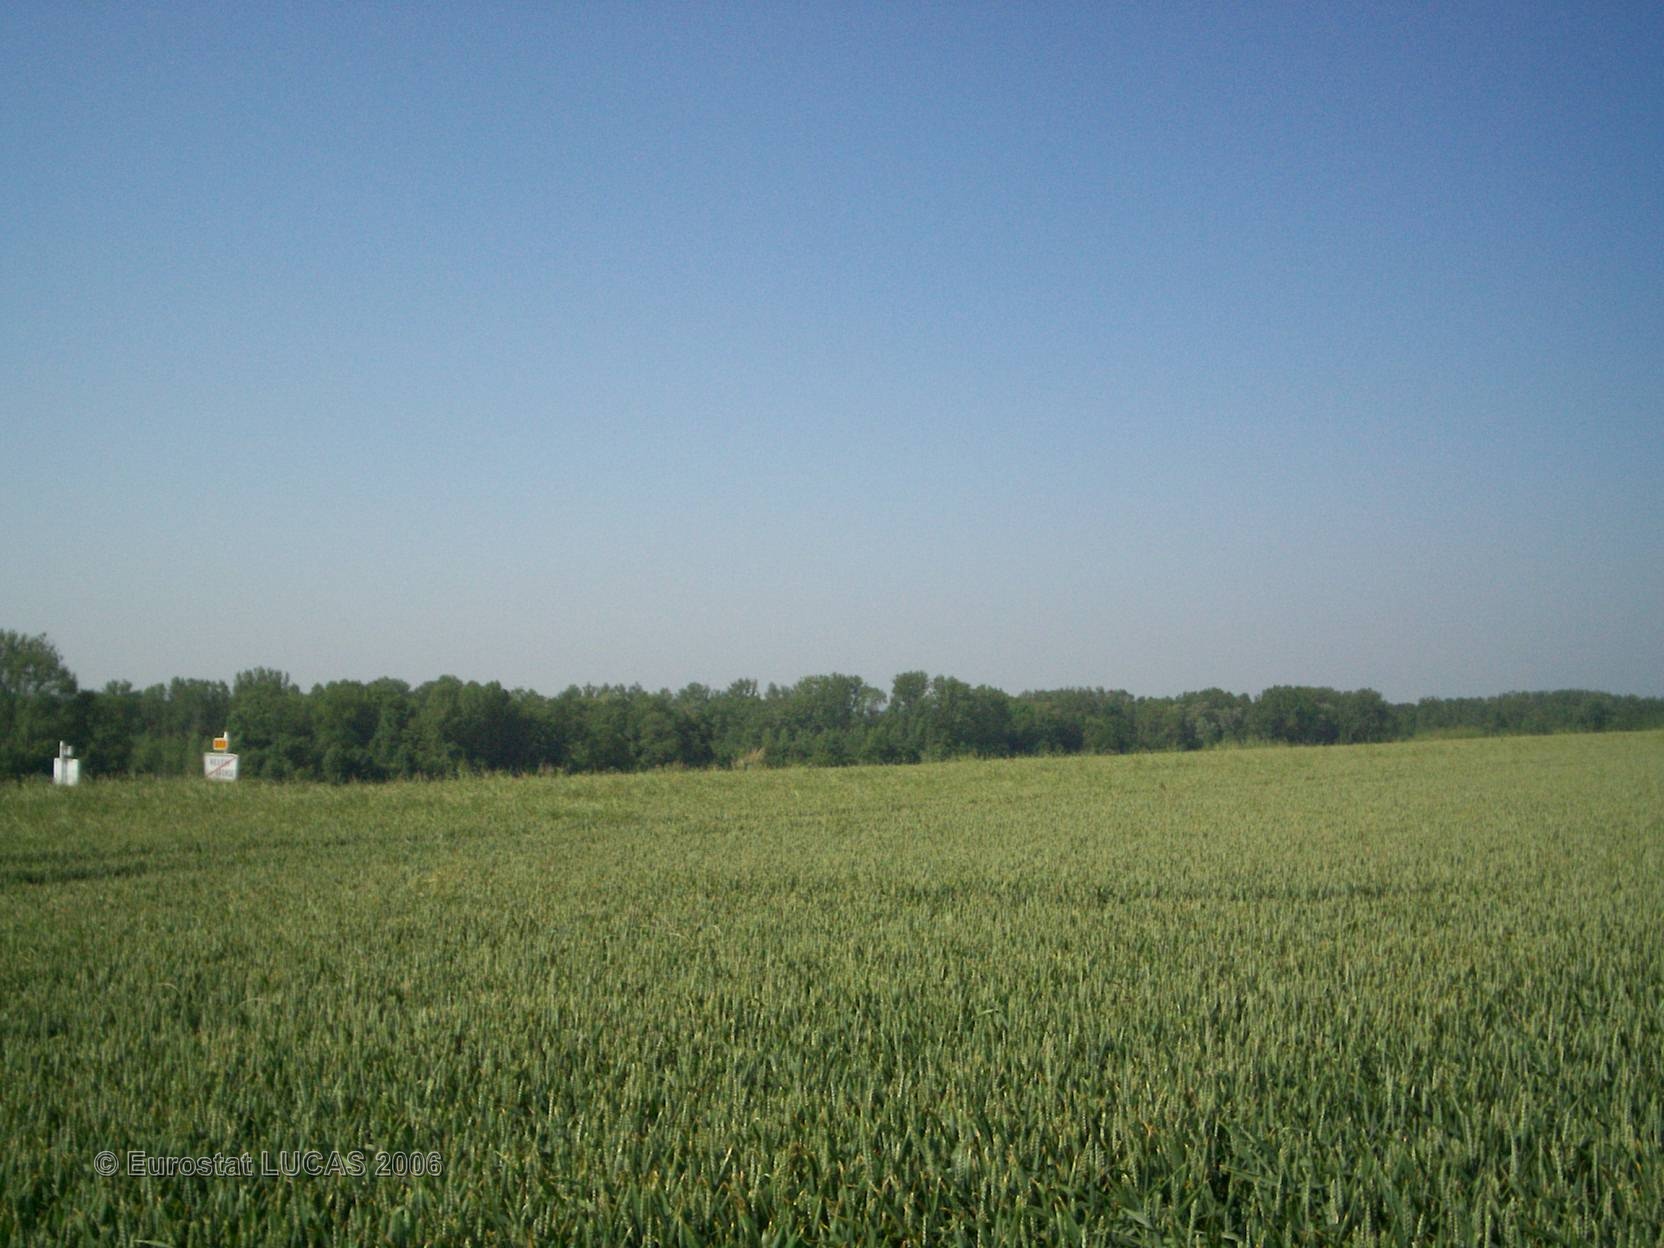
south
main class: Cropland
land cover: Common wheat
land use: Agriculture (excluding fallow land and kitchen gardens)
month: June
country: FR
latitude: 49.4959
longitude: 2.6574
